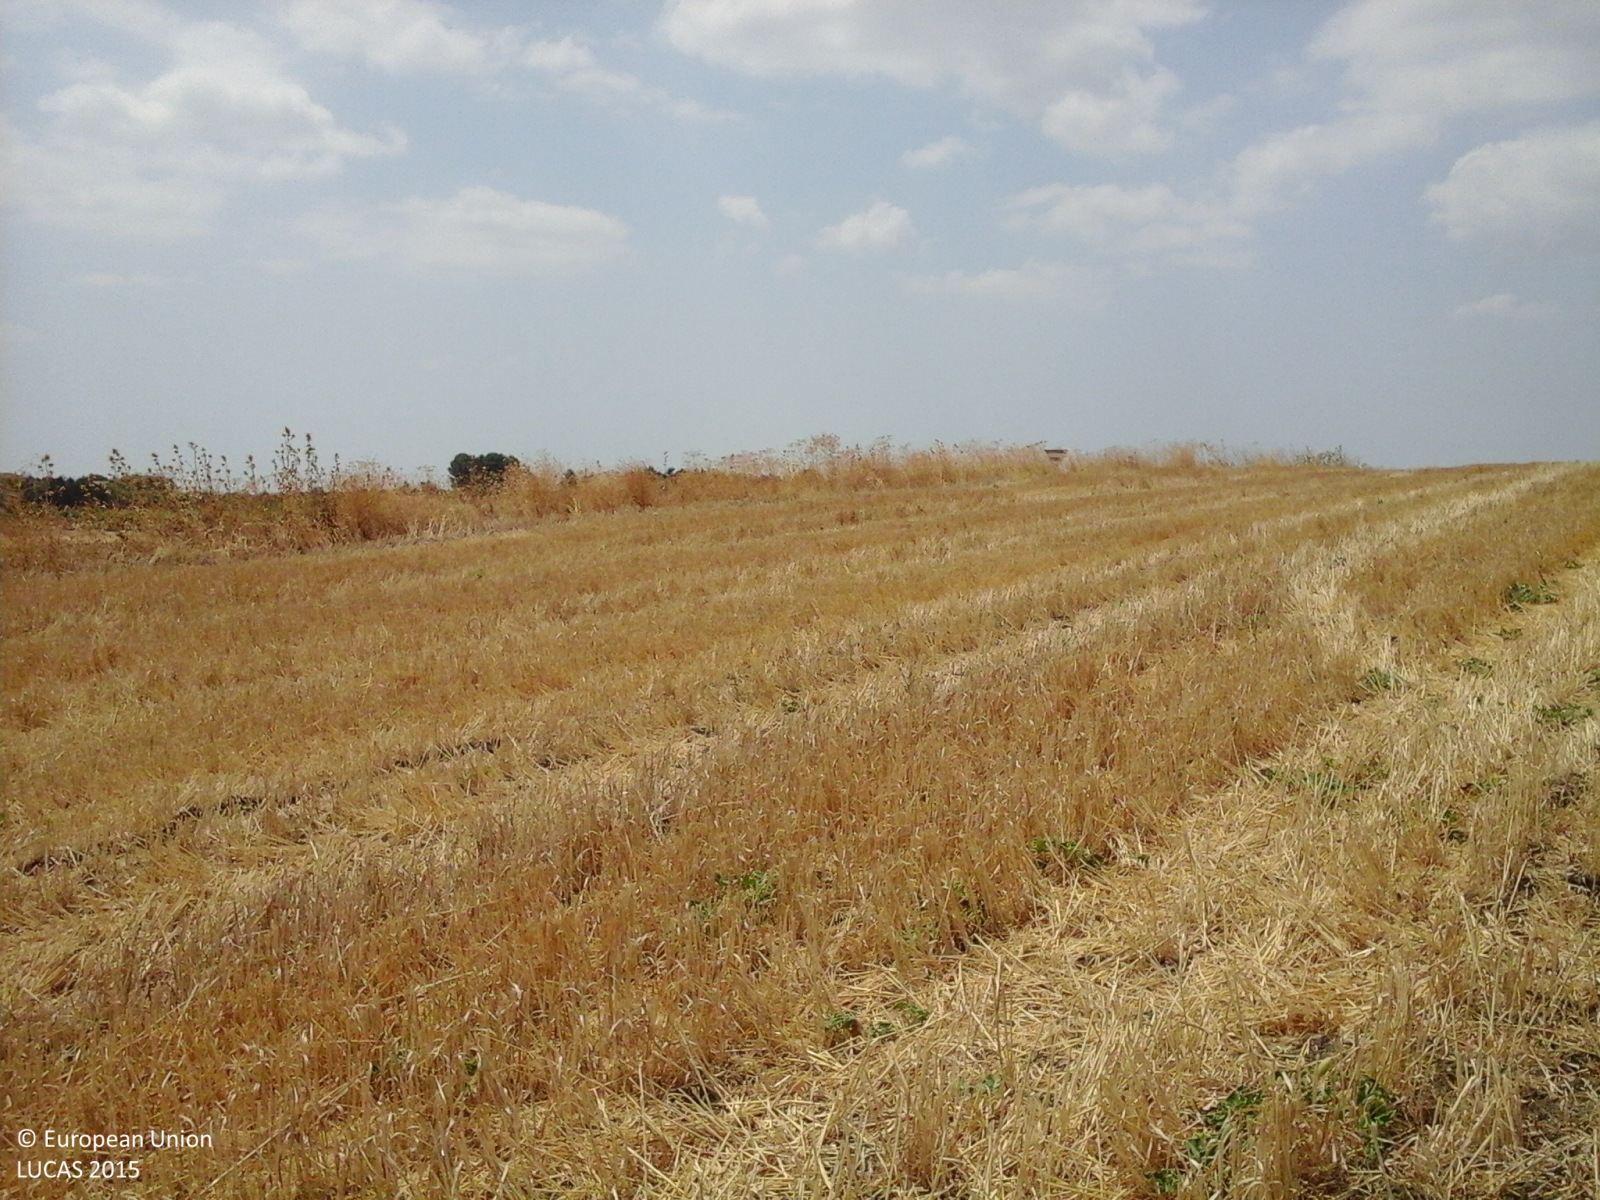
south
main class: Cropland
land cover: Durum wheat
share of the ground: > 75 %
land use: Agriculture (excluding fallow land and kitchen gardens)
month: July
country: IT
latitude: 37.2856
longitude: 13.9062
